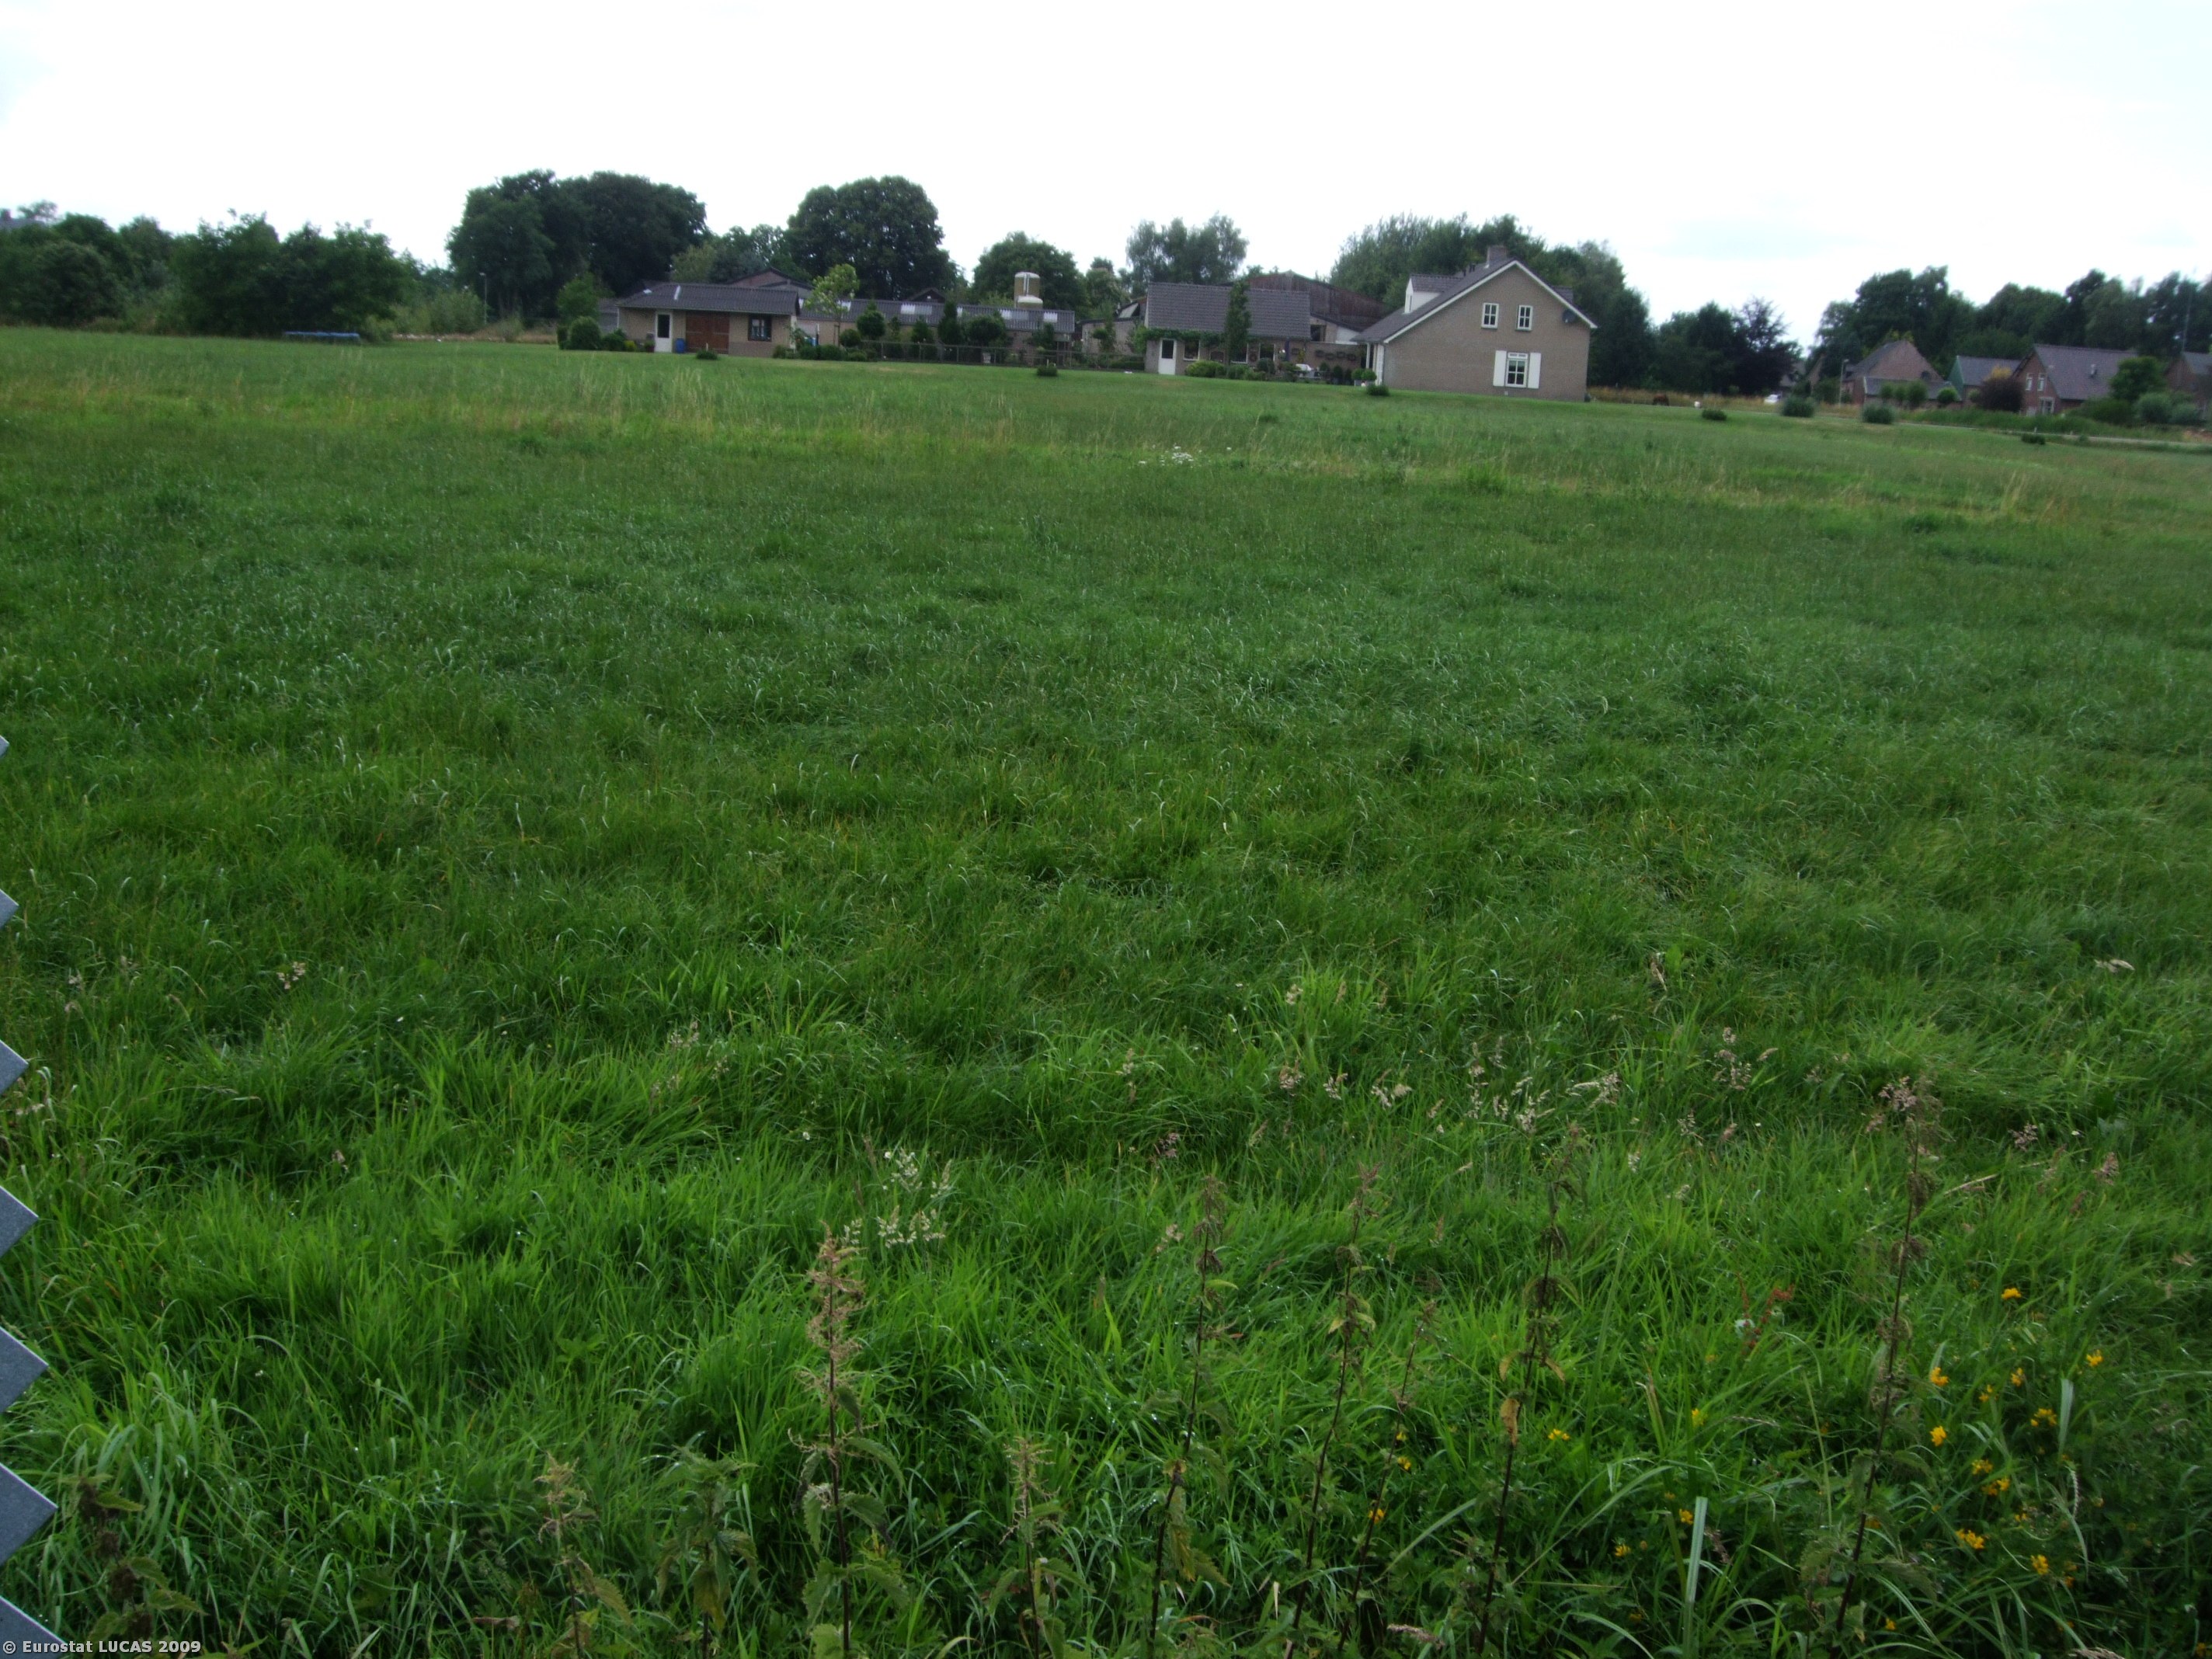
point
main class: Grassland
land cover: Grassland without tree/shrub cover
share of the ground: > 75 %
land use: Agriculture (excluding fallow land and kitchen gardens)
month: July
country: NL
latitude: 51.3371
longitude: 5.4765
